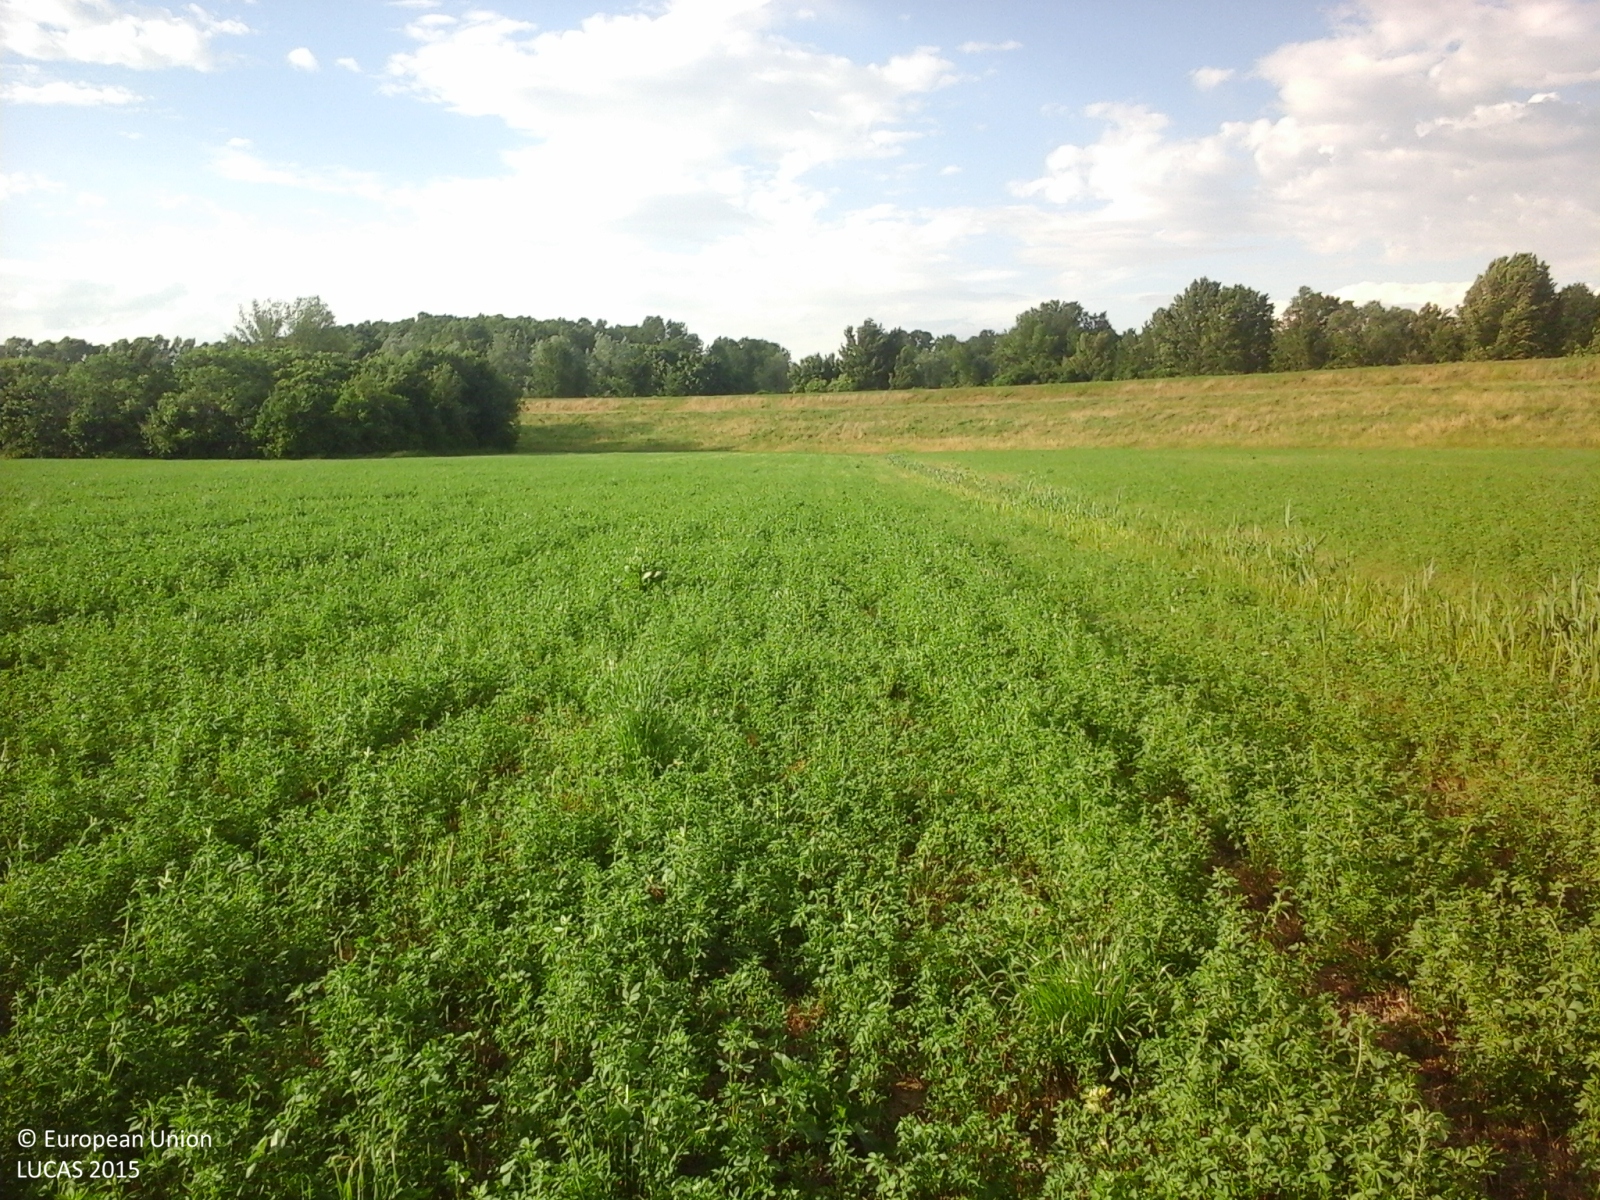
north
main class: Cropland
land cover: Lucerne
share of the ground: > 75 %
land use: Agriculture (excluding fallow land and kitchen gardens)
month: May
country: IT
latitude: 45.1040
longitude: 10.9006
